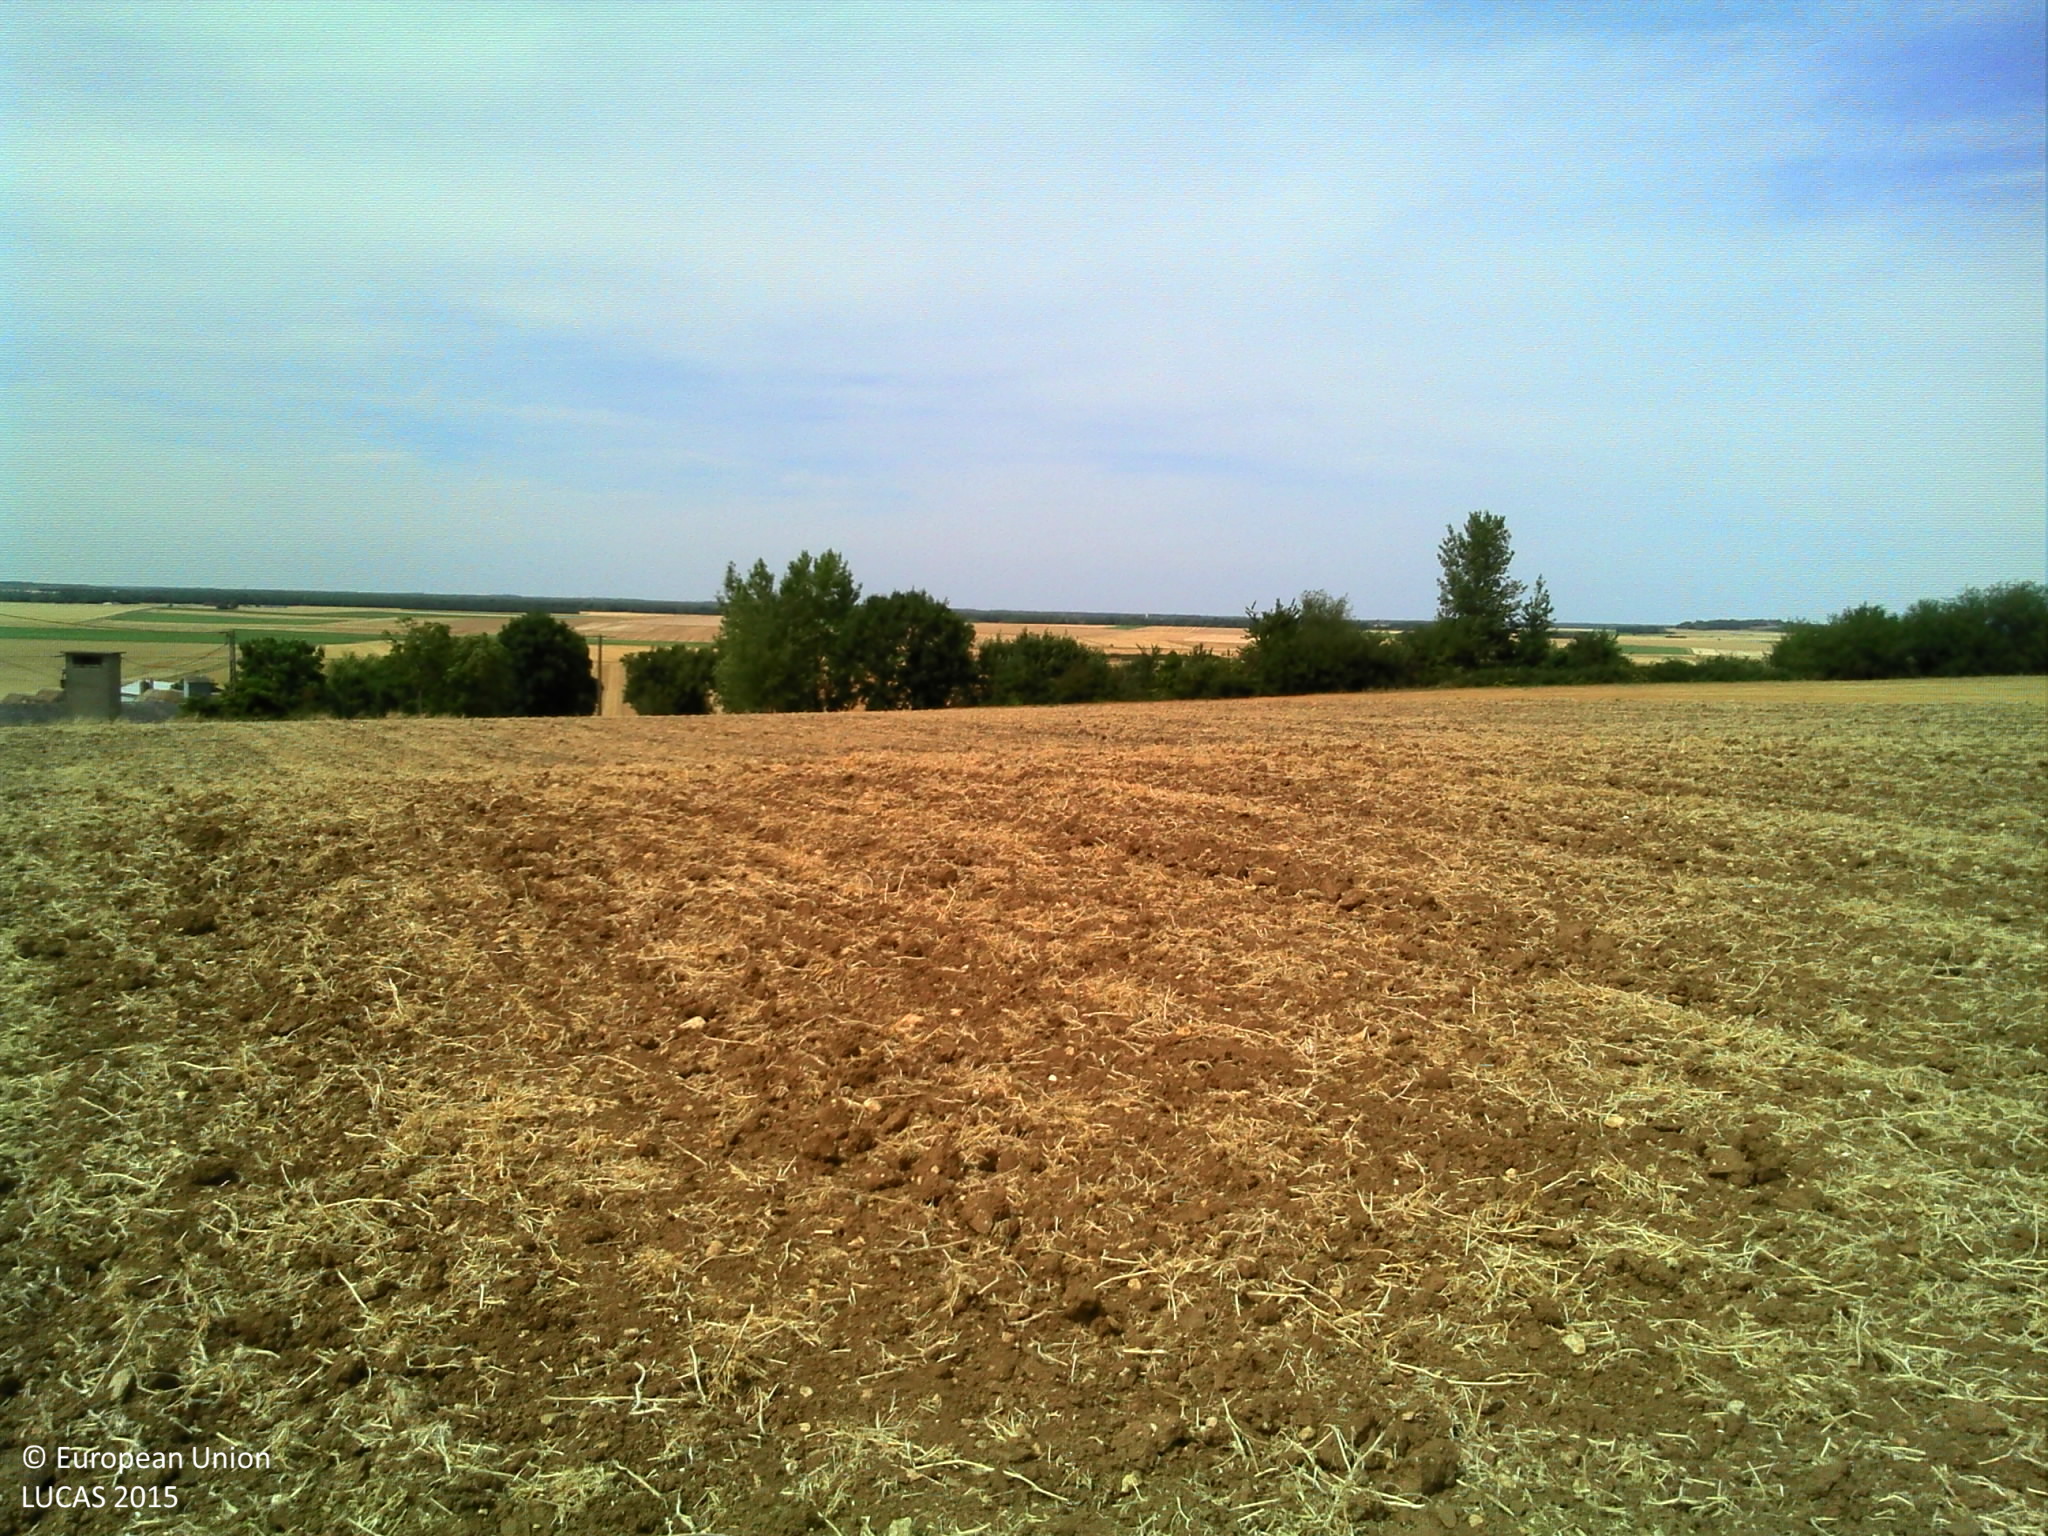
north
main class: Cropland
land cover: Dry pulses
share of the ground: > 75 %
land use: Agriculture (excluding fallow land and kitchen gardens)
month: August
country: FR
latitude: 48.2186
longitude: 2.4660
